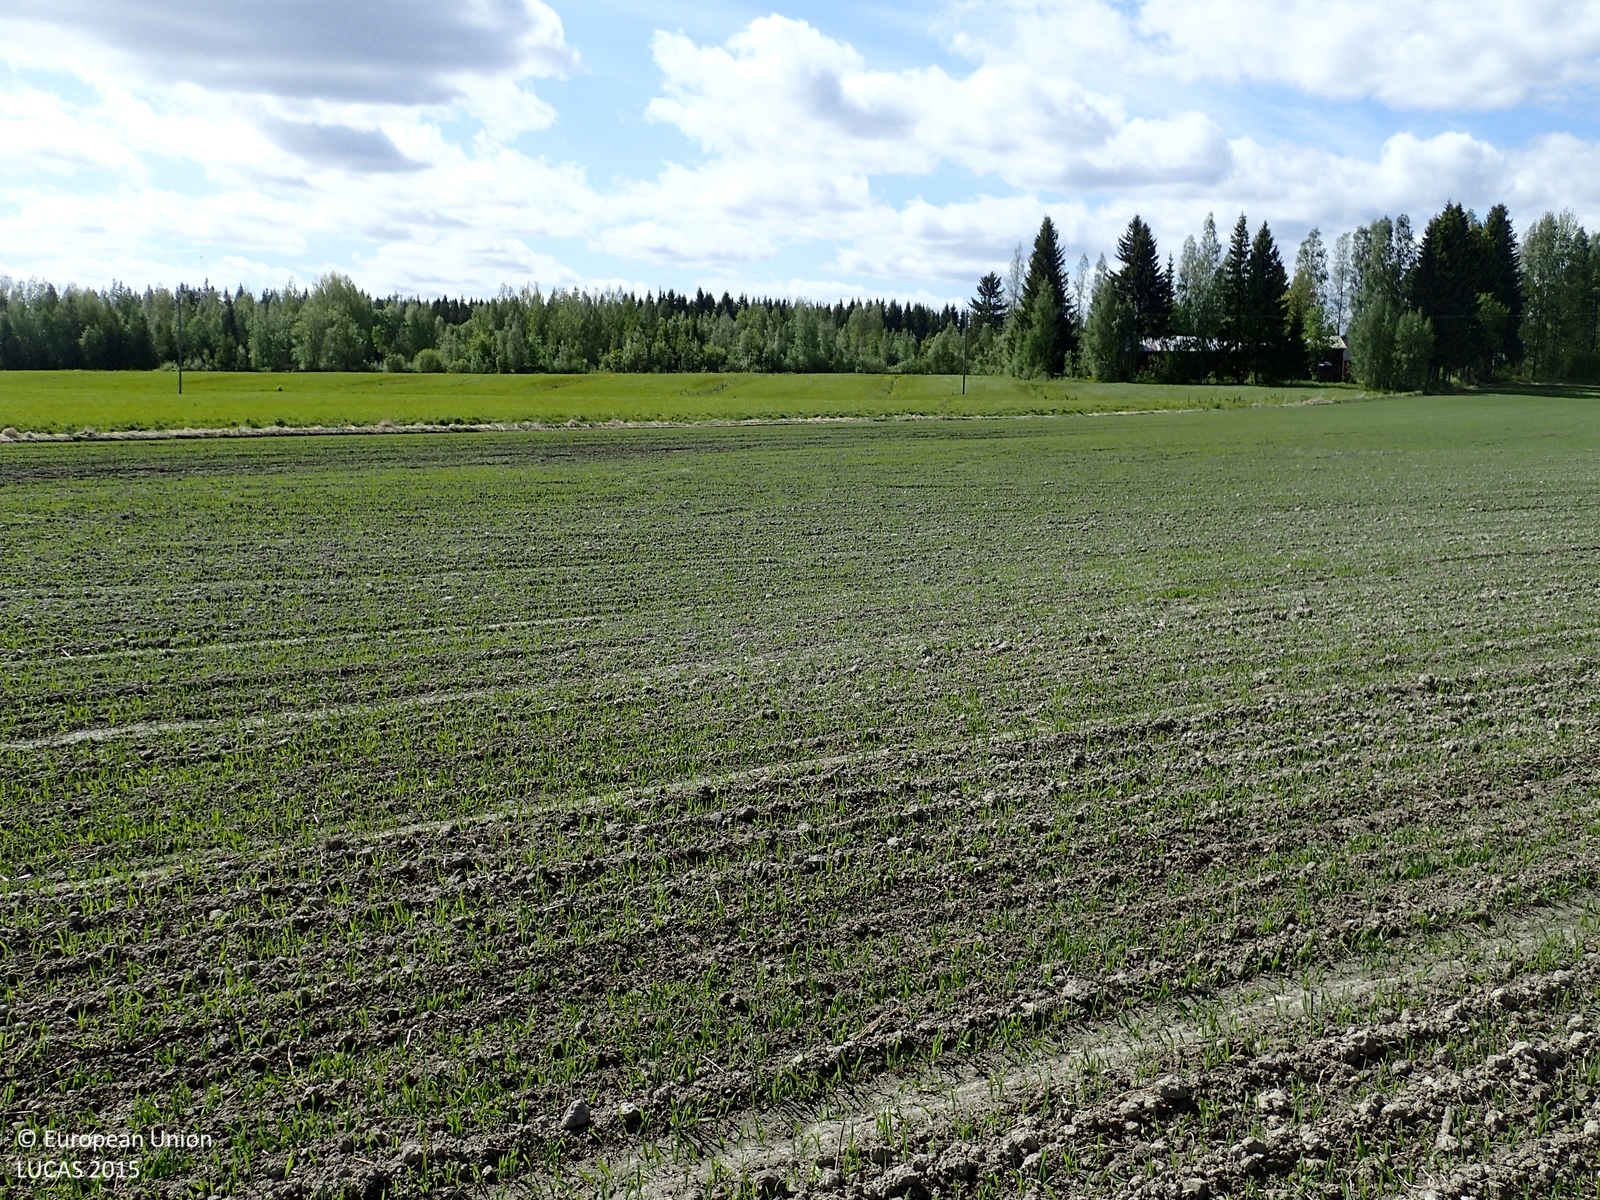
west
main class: Cropland
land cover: Oats
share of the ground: 25 - 50 %
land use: Agriculture (excluding fallow land and kitchen gardens)
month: June
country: FI
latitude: 62.1926
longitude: 22.9973
